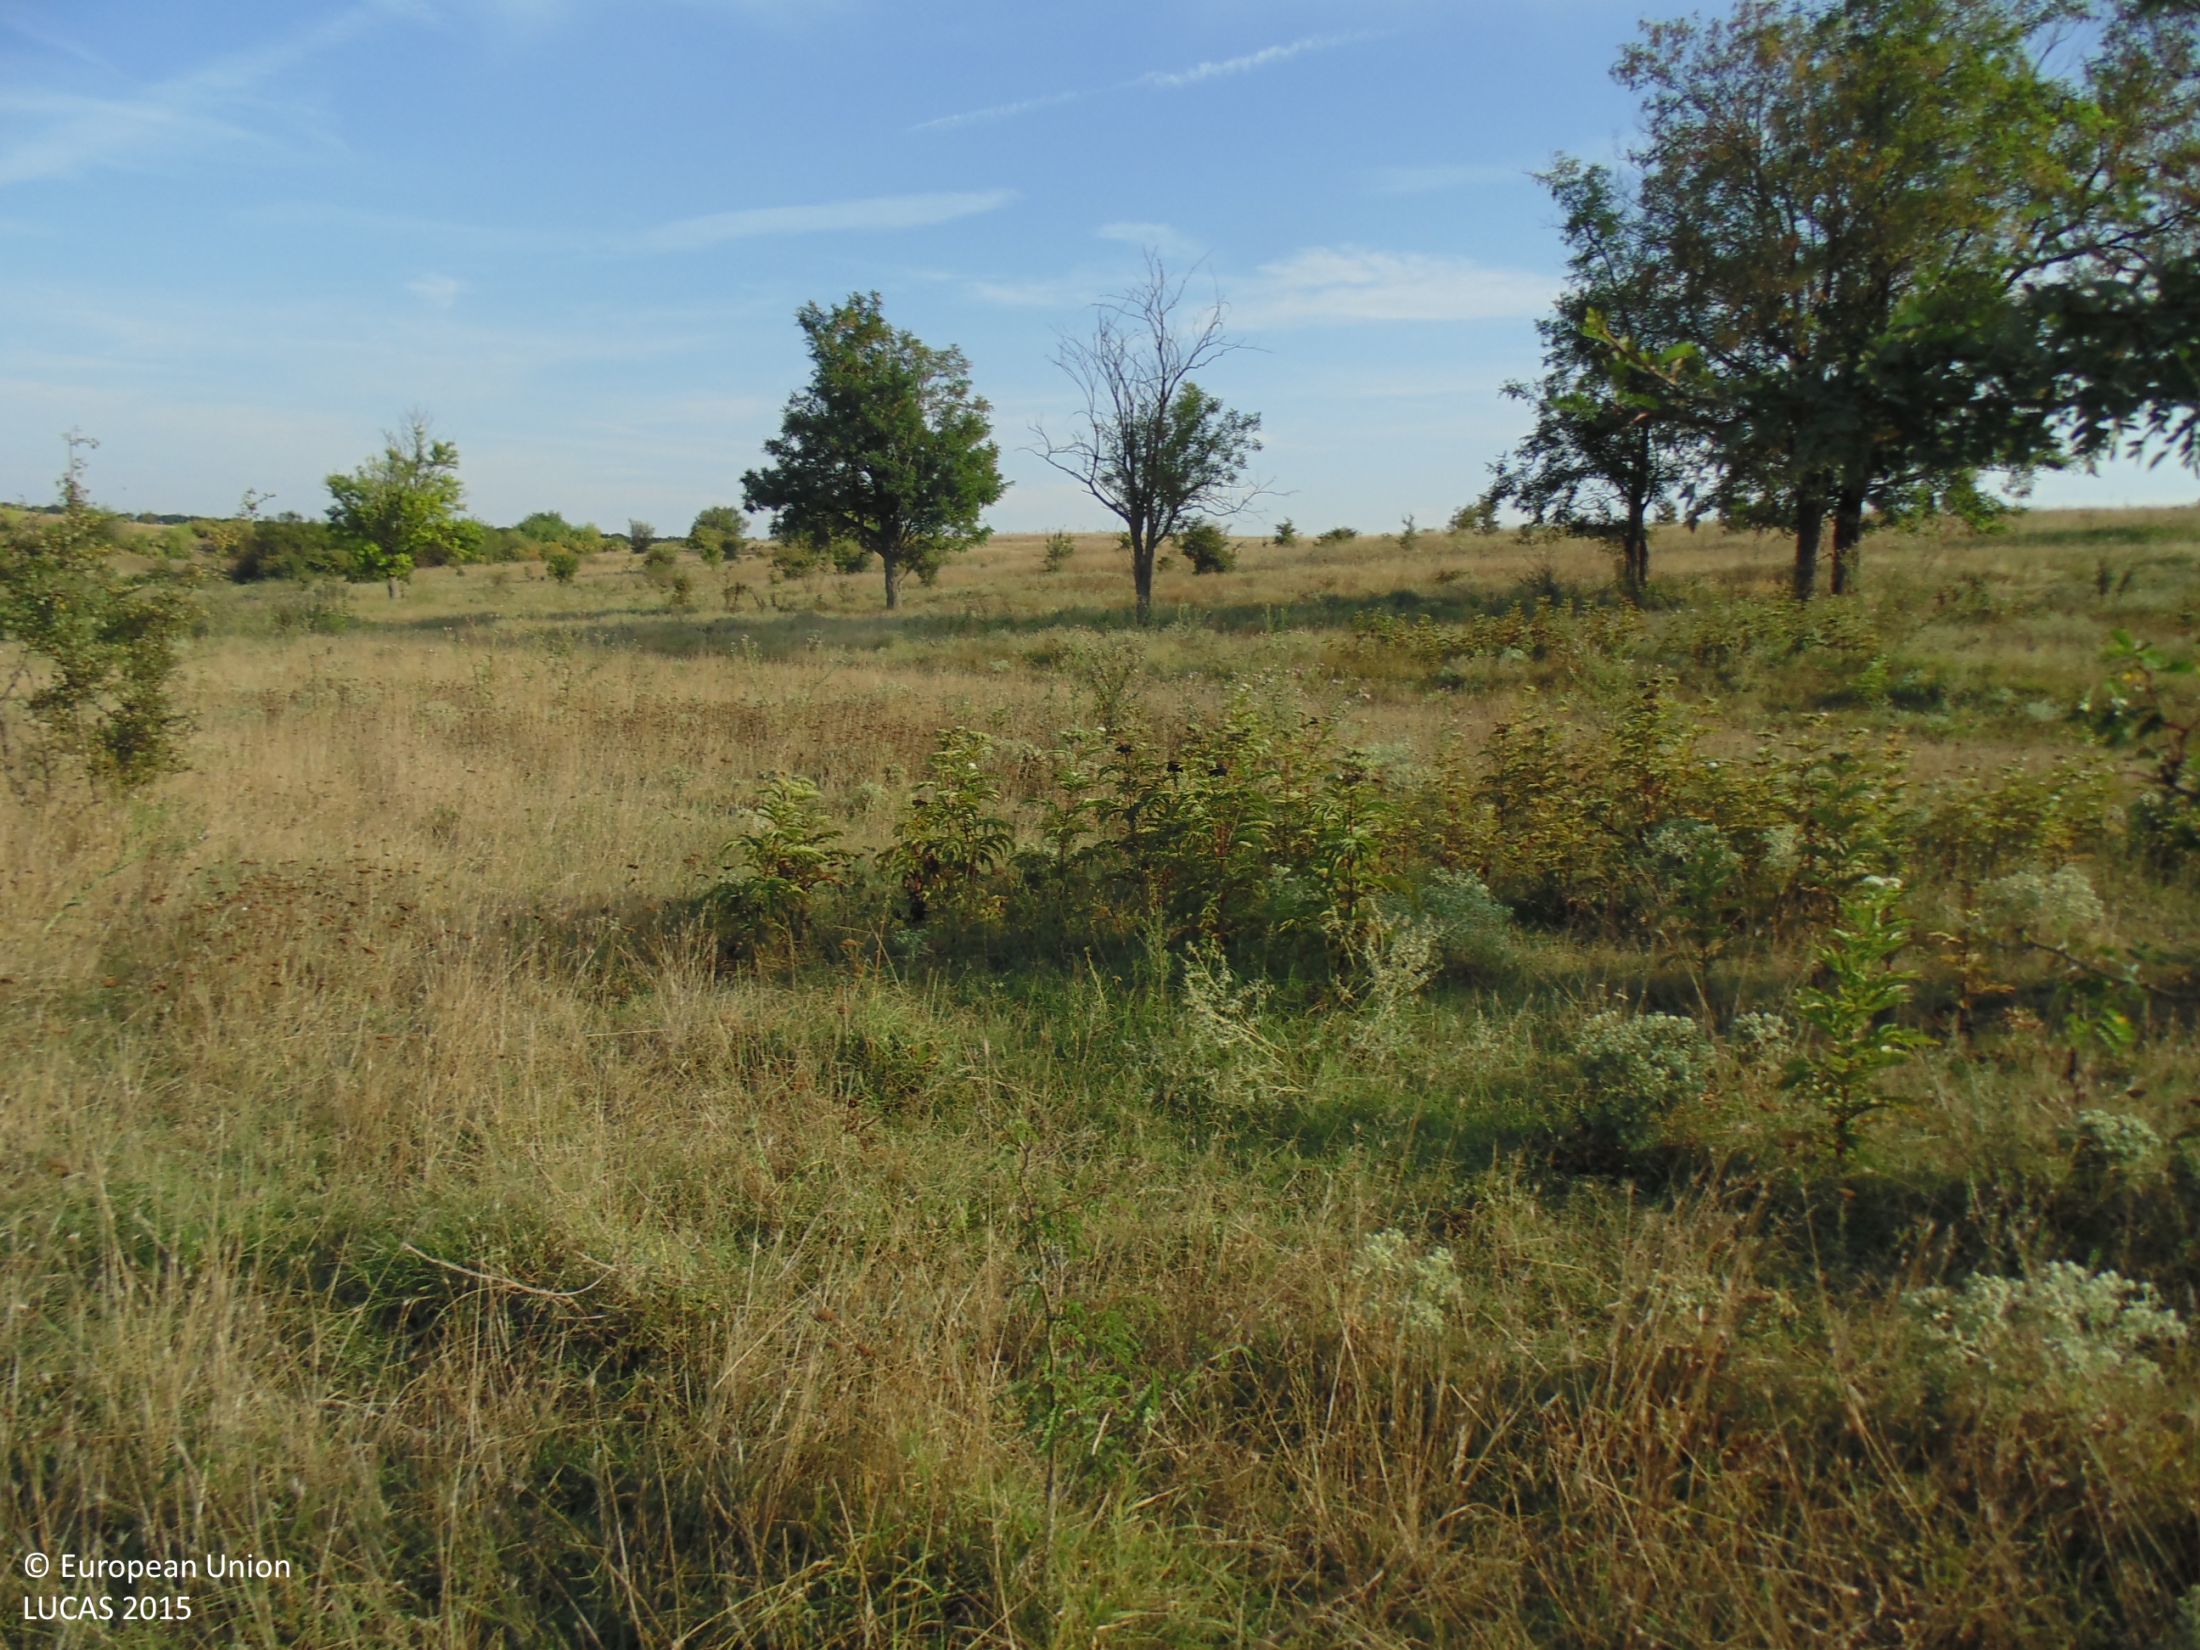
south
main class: Grassland
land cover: Grassland with sparse tree/shrub cover
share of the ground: > 75 %
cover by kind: herbaceous plants 90 %, broadleaved forest trees 5 %, shrubs 5 %
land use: Agriculture (excluding fallow land and kitchen gardens)
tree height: < 5 m
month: August
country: BG
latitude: 43.6658
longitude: 28.3003
